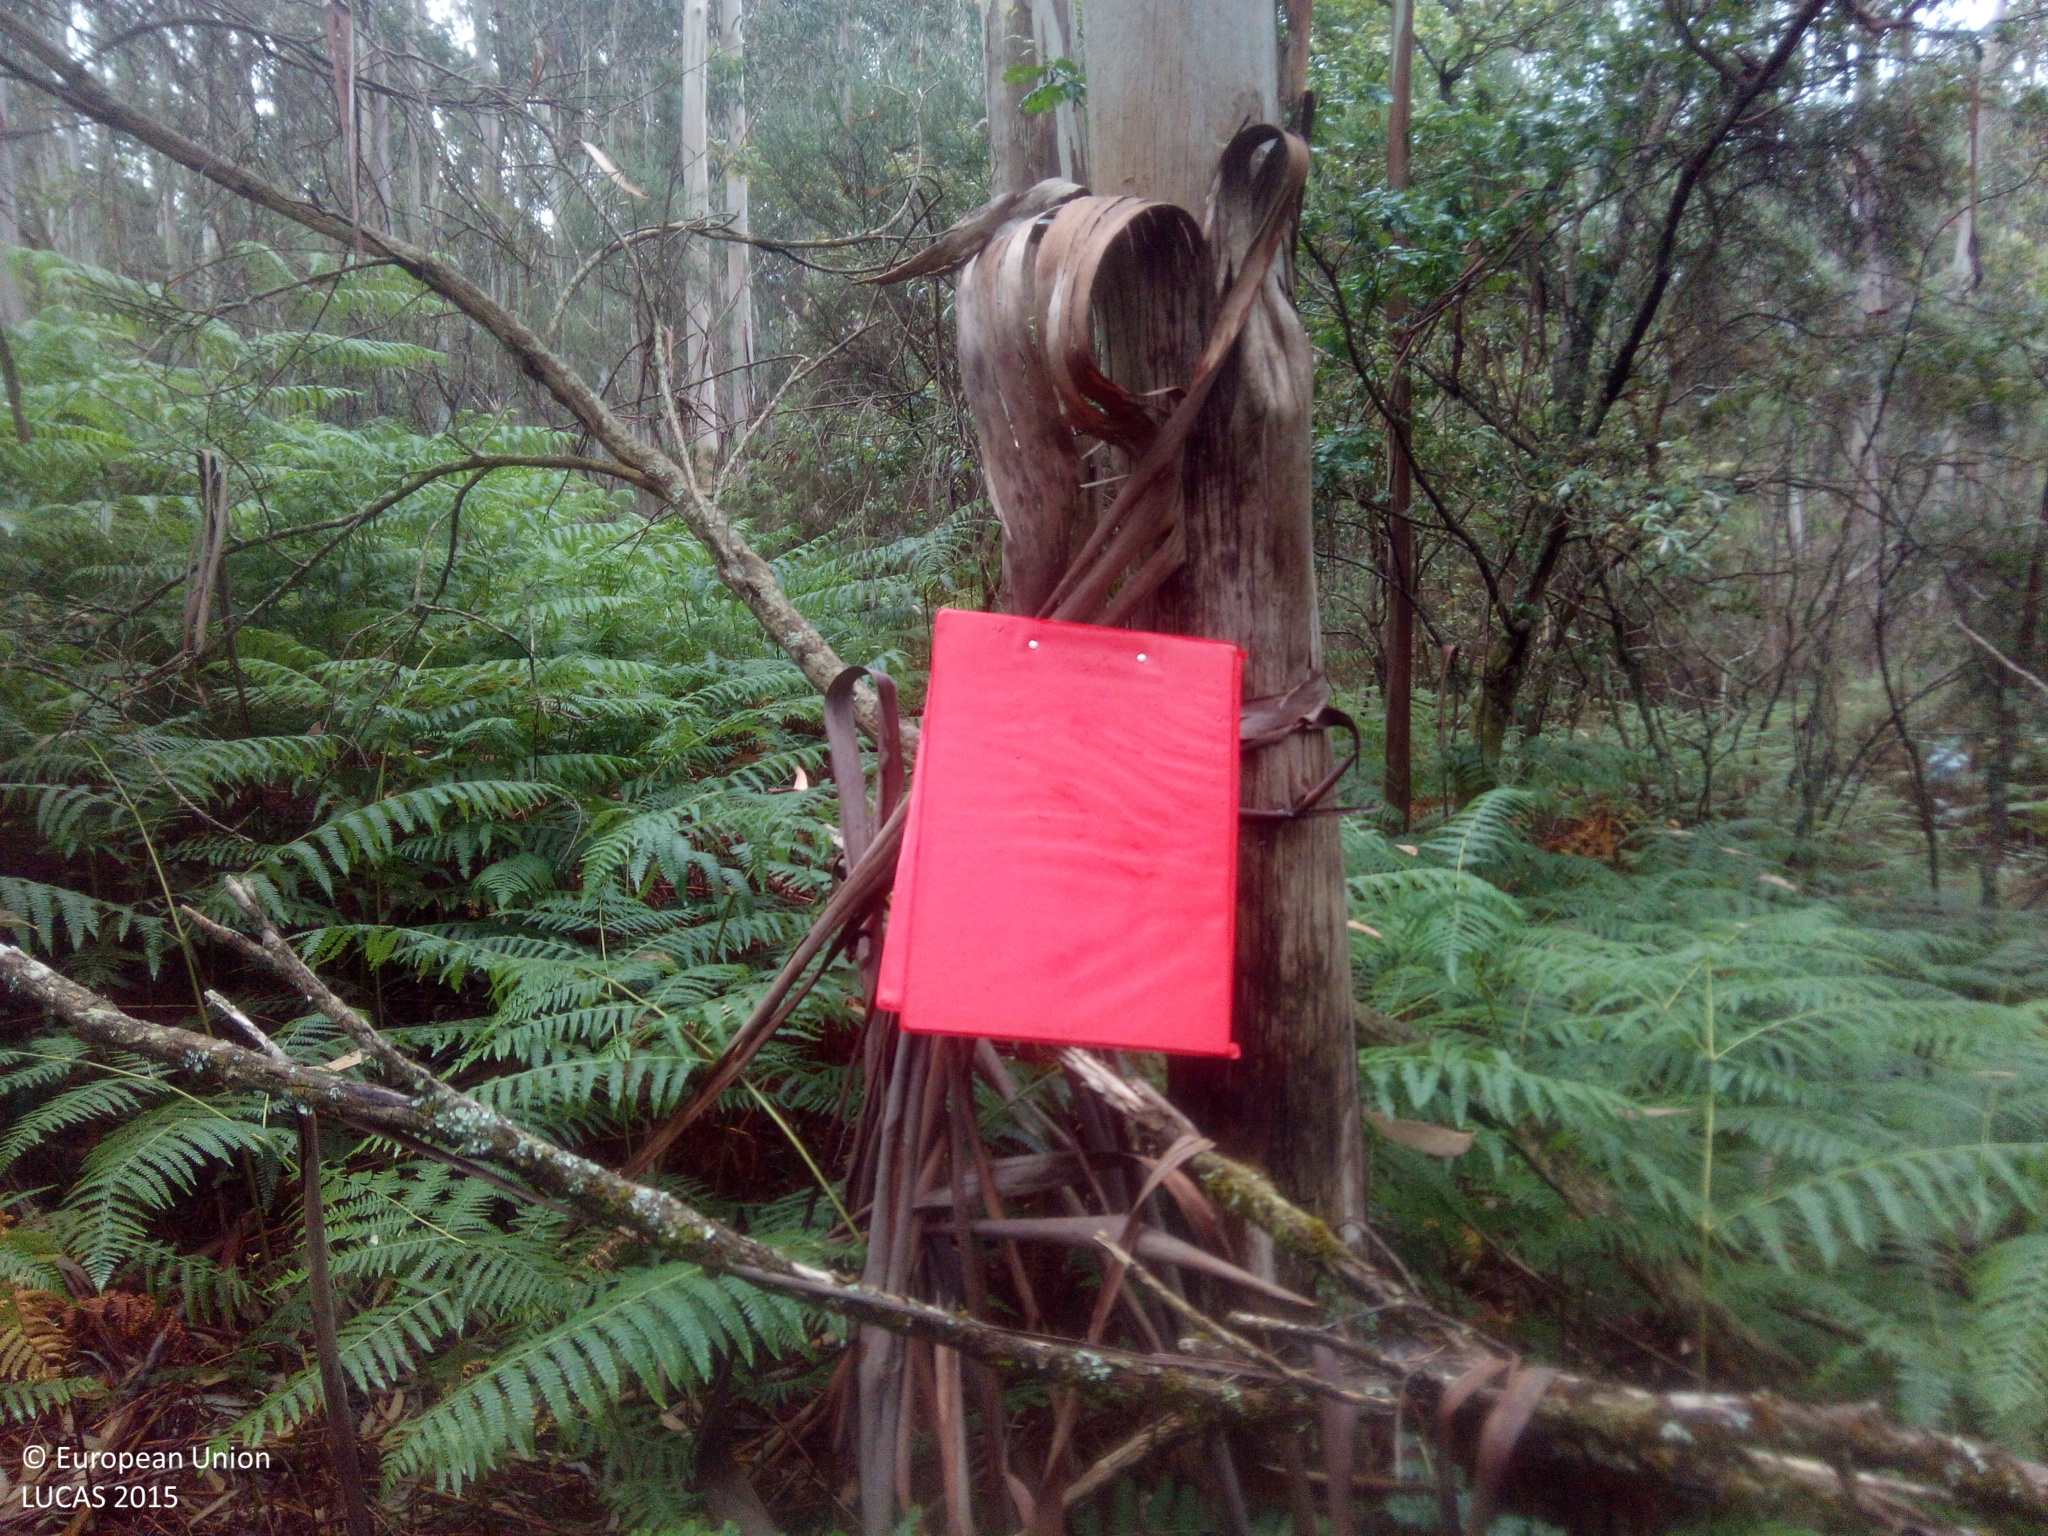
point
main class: Woodland
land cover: Broadleaved woodland
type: exotic forest
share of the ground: > 75 %
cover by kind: broadleaved forest trees 100 %
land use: Forestry
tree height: > 5 m
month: July
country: ES
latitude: 42.2742
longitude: -8.3382
